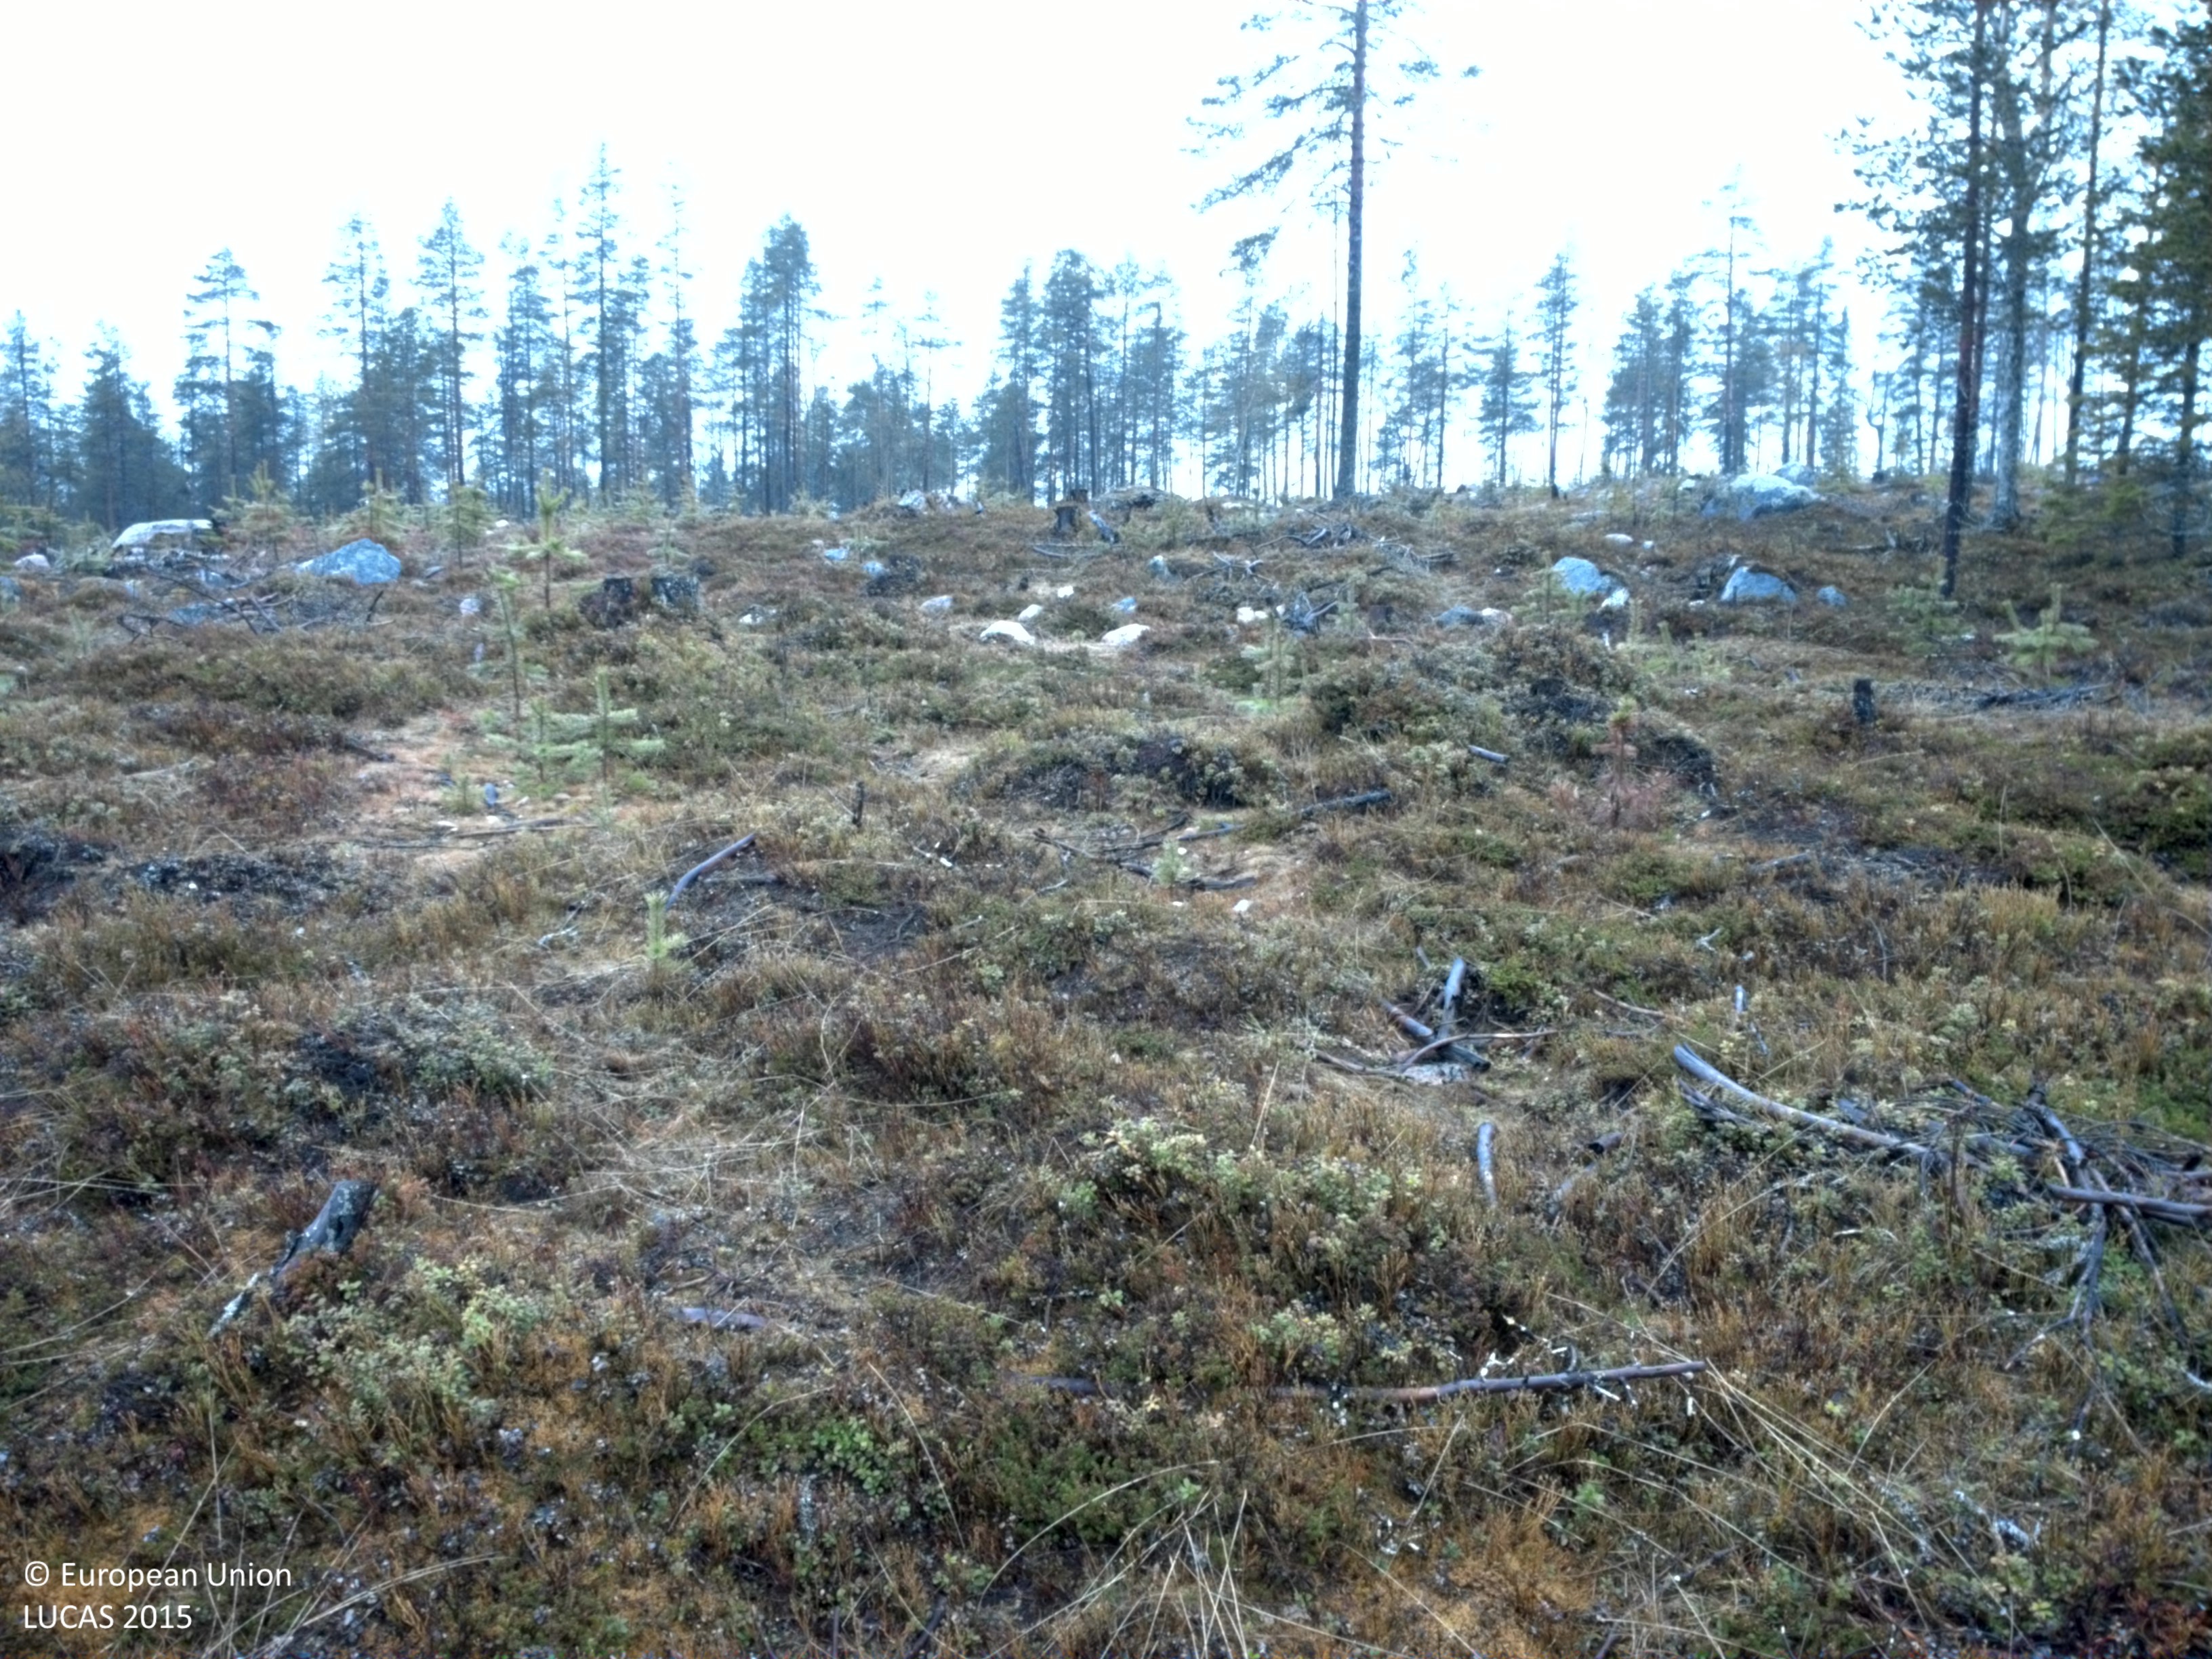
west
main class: Shrubland
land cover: Shrubland with sparse tree cover
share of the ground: > 75 %
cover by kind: shrubs 95 %, coniferous forest trees 5 %
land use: Forestry
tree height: < 5 m
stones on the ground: 10 - 25 %
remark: Clear cut
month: May
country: SE
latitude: 66.2859
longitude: 23.2418
